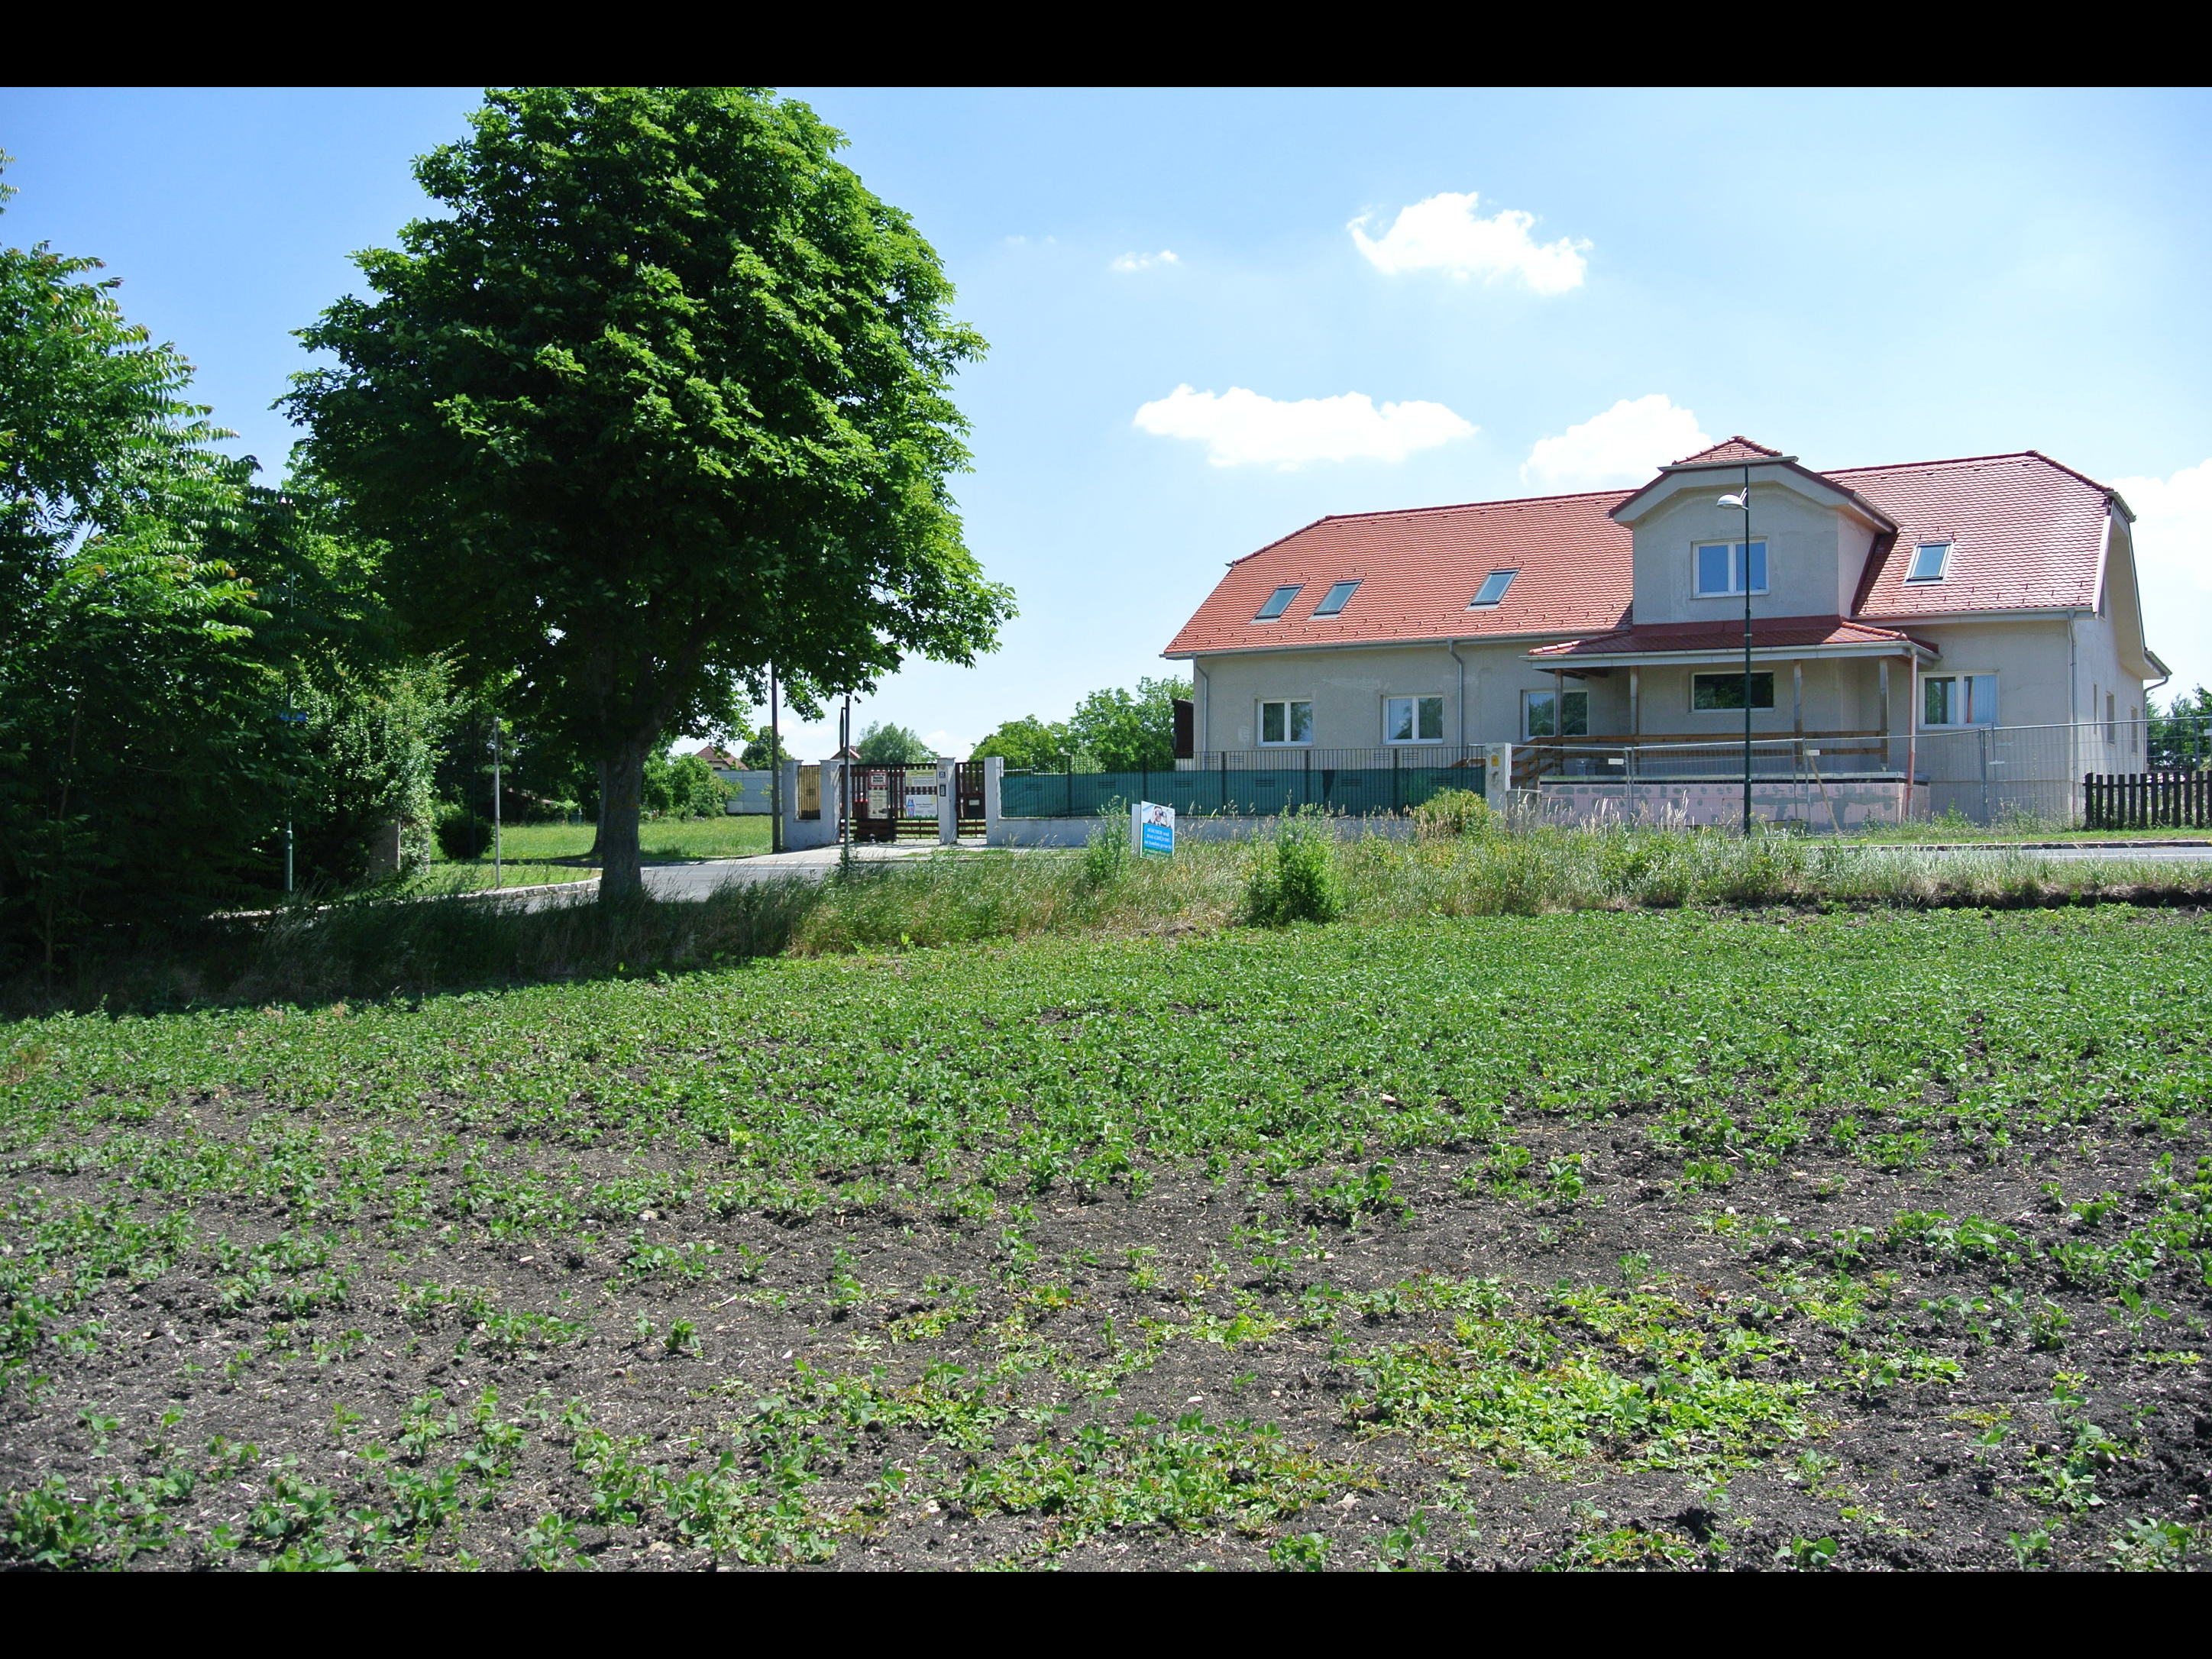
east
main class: Cropland
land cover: Soya
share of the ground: > 75 %
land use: Agriculture (excluding fallow land and kitchen gardens)
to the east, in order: Soya; Grass margins; Lines of trees; Artificial constructions in urban areas; Grassland without tree/shrub cover; Broadleaved woodland; Artificial constructions in urban areas; Grassland without tree/shrub cover; Broadleaved woodland; Grassland without tree/shrub cover; Common wheat
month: June
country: AT
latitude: 47.7818
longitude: 16.4507
